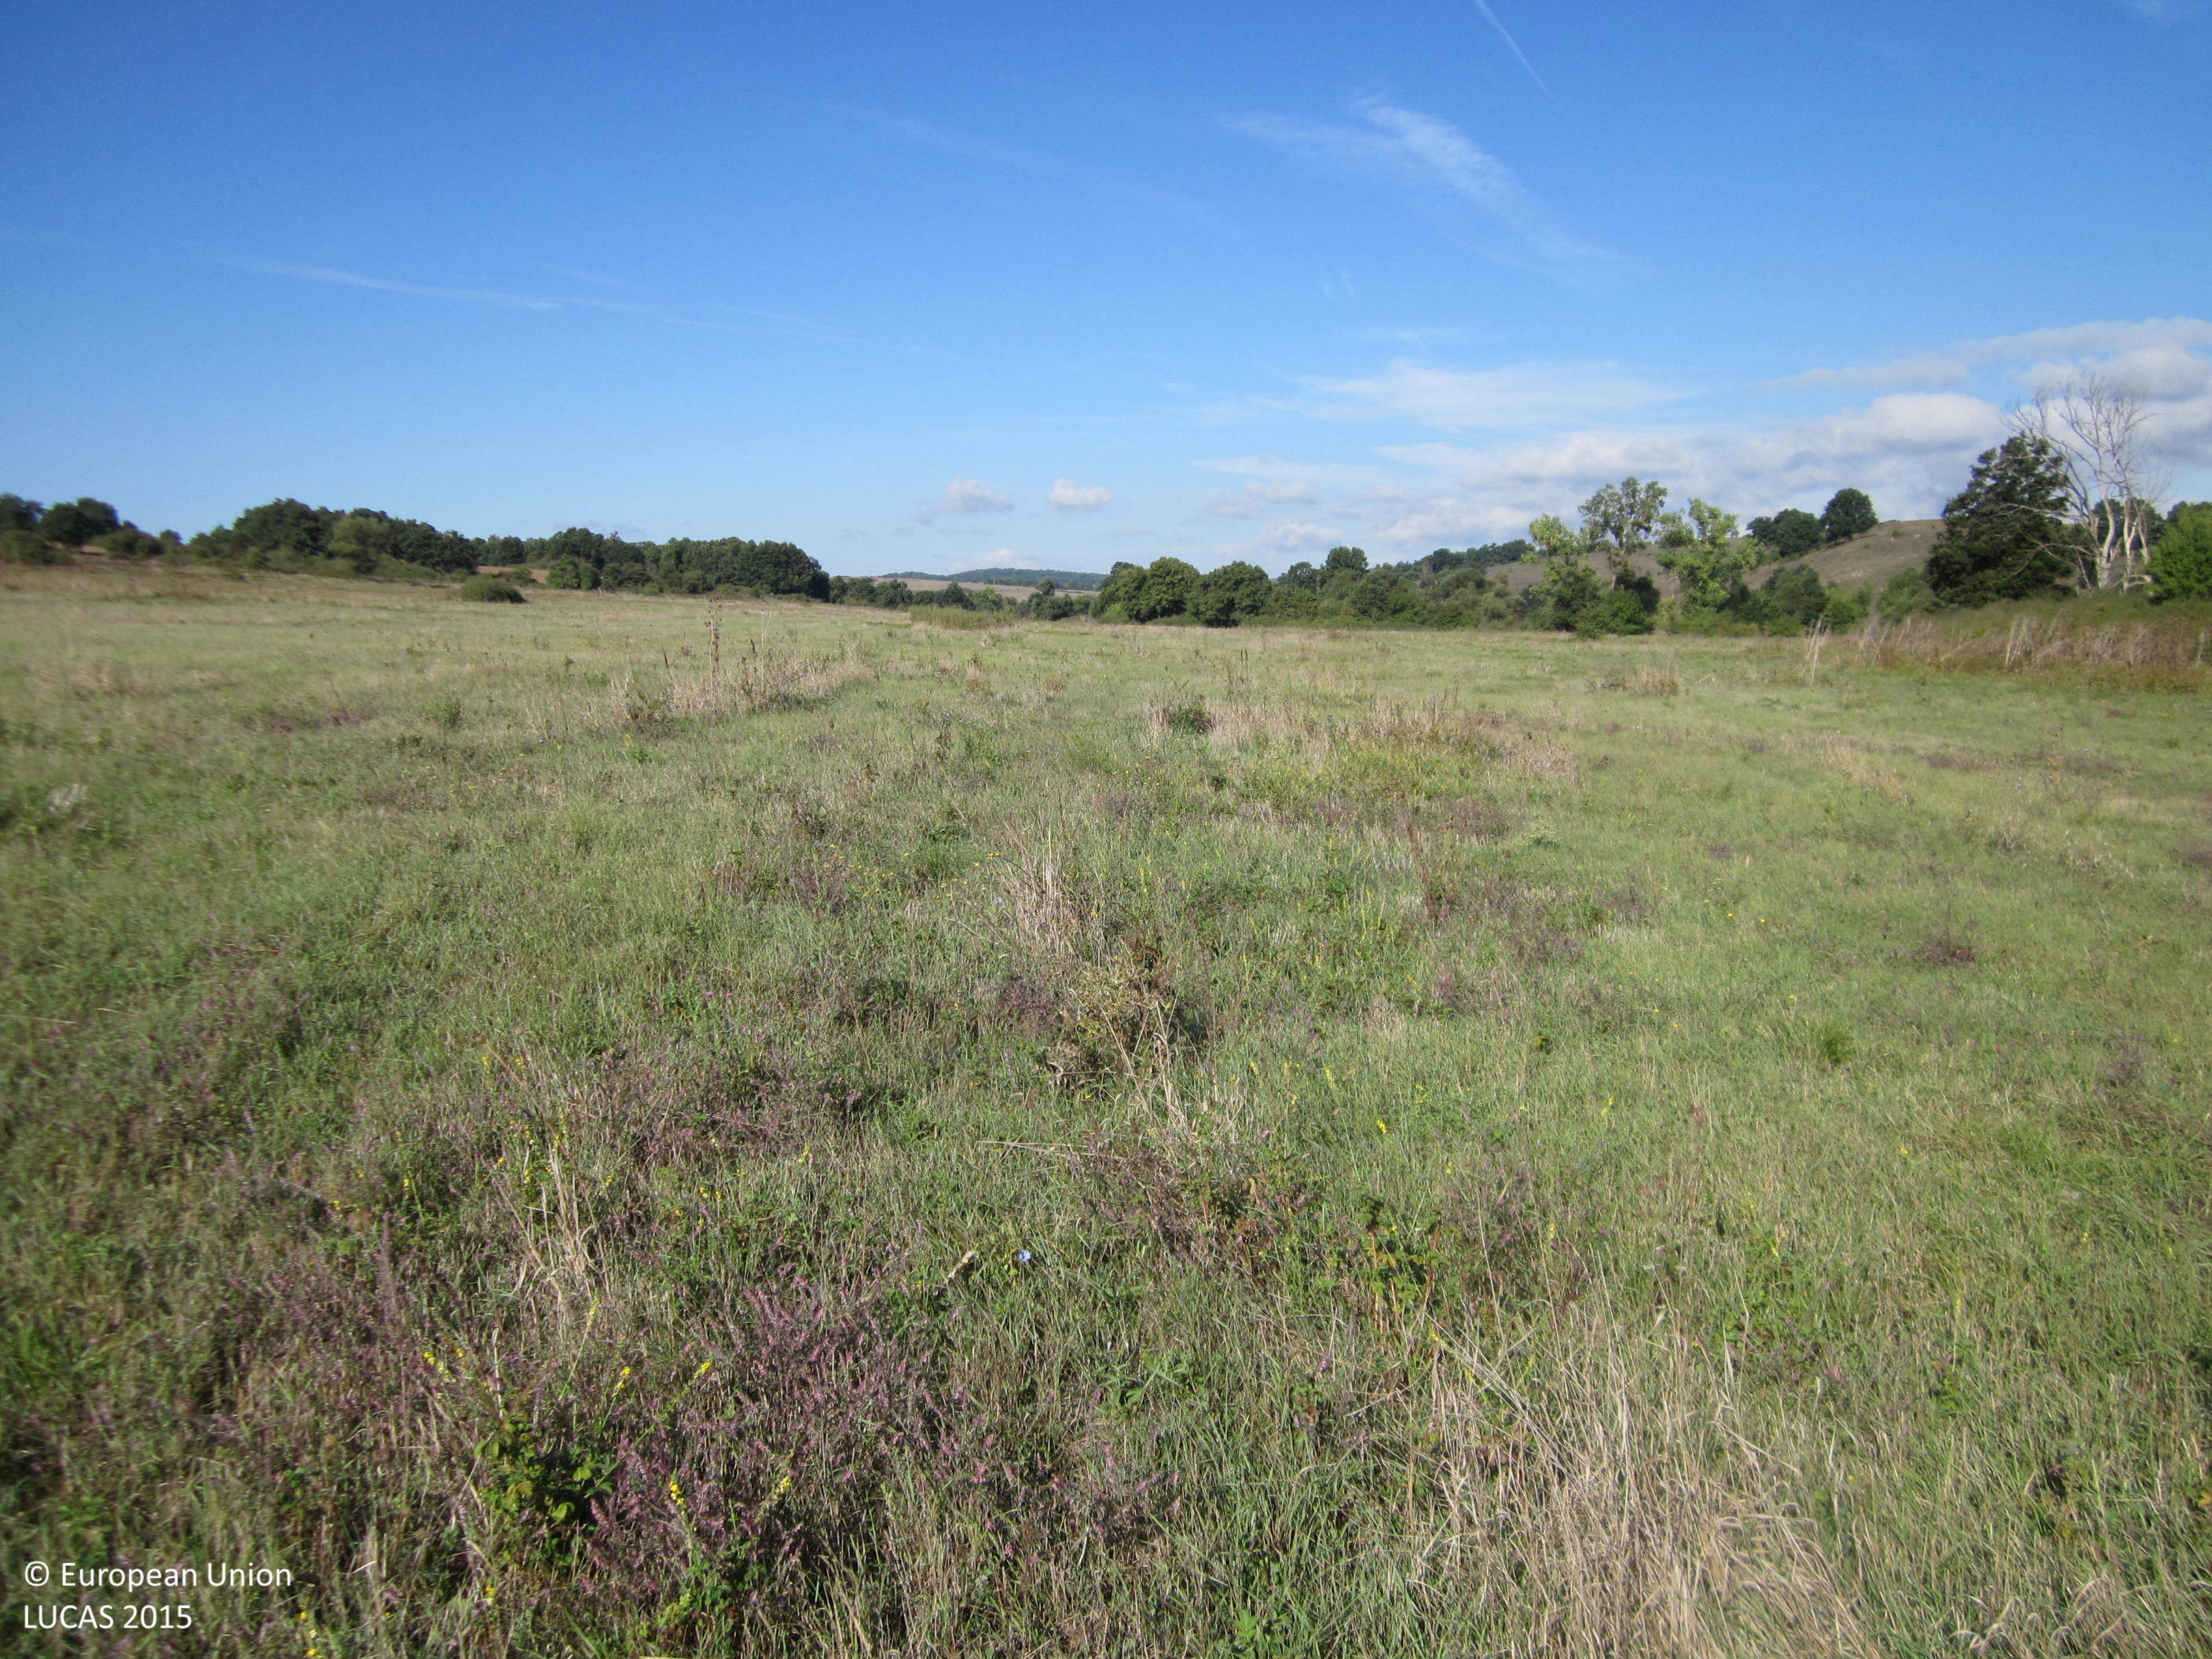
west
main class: Grassland
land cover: Grassland without tree/shrub cover
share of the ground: > 75 %
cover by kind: herbaceous plants 100 %
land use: Agriculture (excluding fallow land and kitchen gardens)
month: September
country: BG
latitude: 42.1794
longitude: 27.1133
